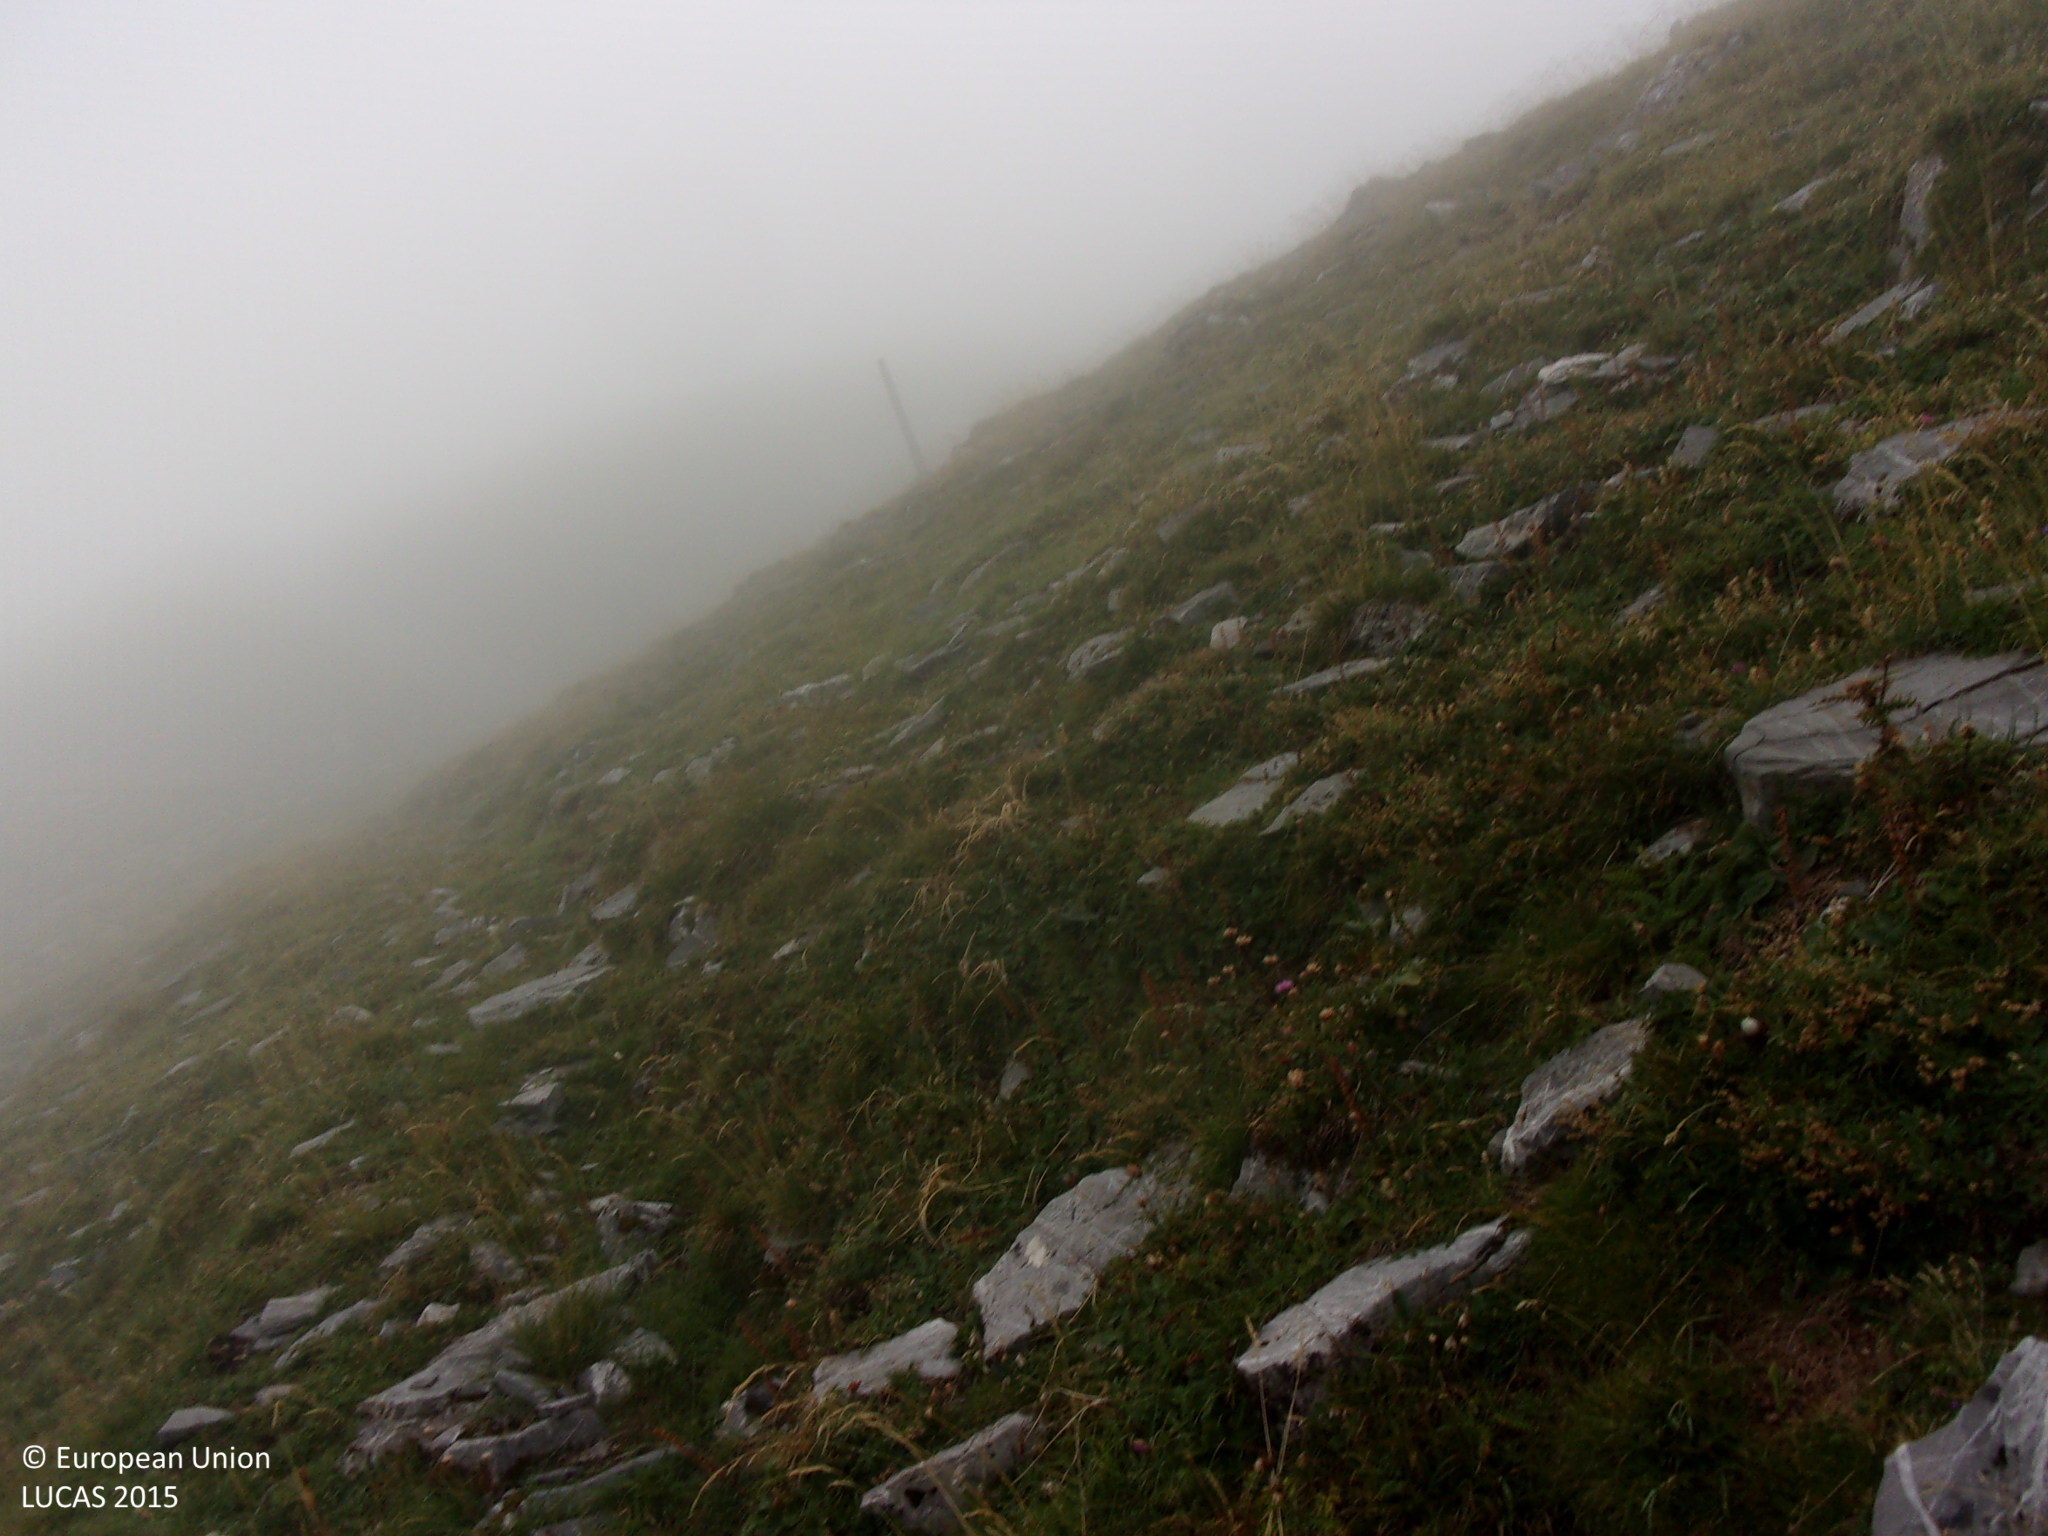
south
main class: Grassland
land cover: Grassland without tree/shrub cover
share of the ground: > 75 %
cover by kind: herbaceous plants 80 %, consolidated bare surface 20 %
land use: Semi-natural and natural areas not in use
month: August
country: ES
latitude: 42.7771
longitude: -0.5279
